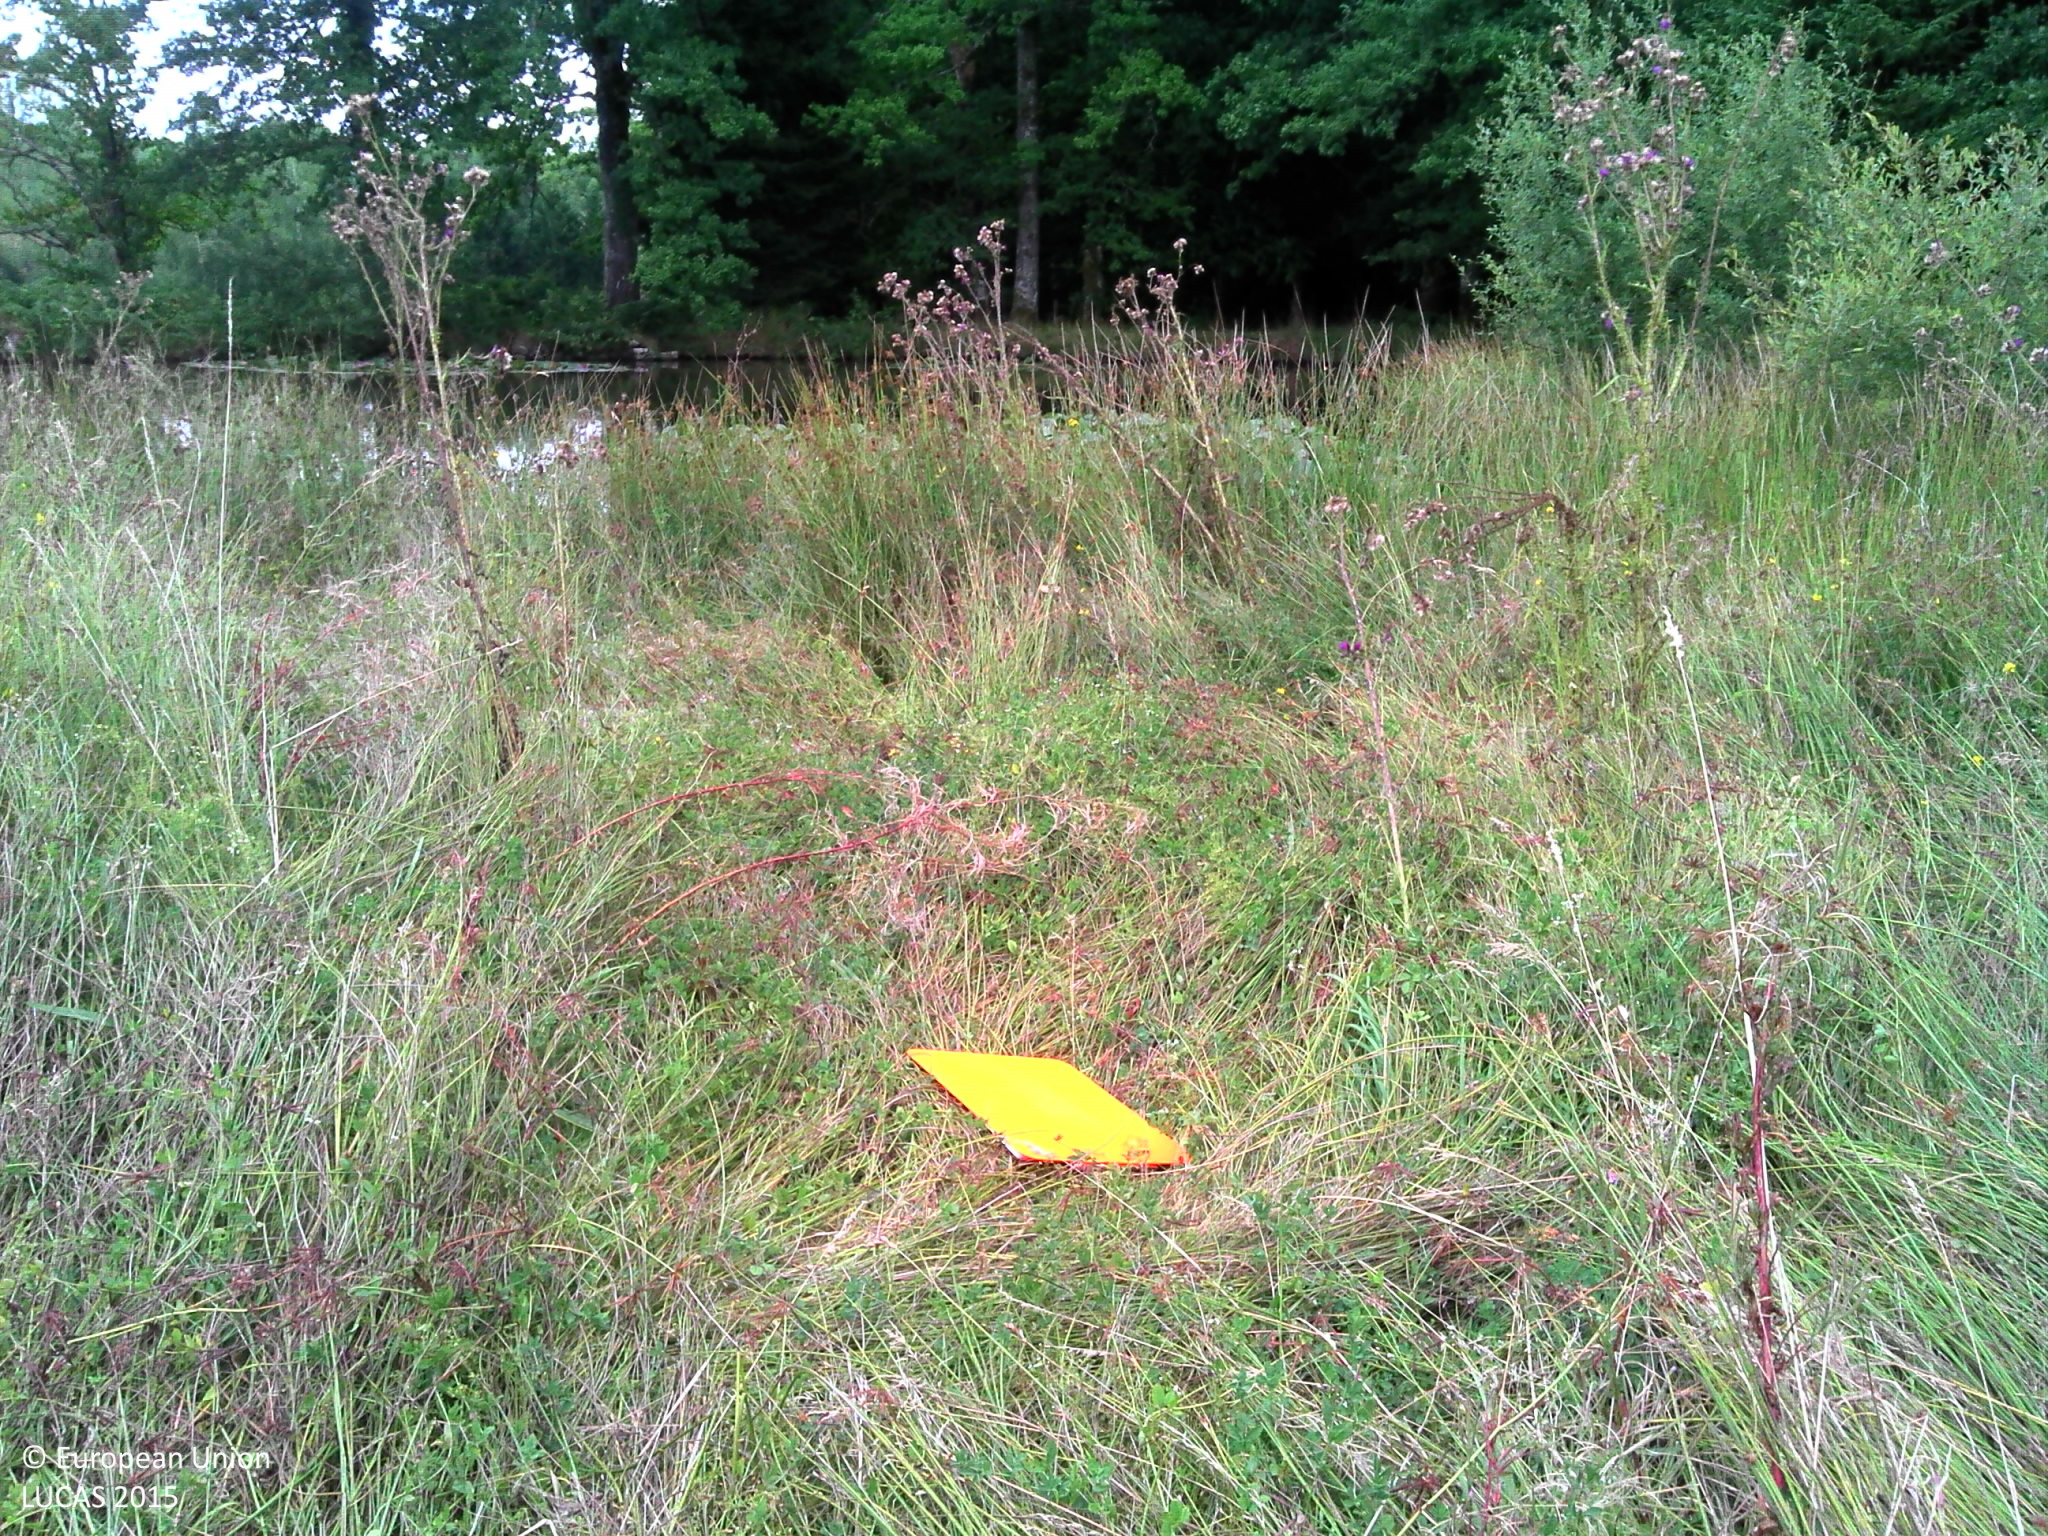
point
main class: Grassland
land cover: Grassland without tree/shrub cover
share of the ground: > 75 %
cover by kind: herbaceous plants 100 %
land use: Agriculture (excluding fallow land and kitchen gardens)
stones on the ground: < 10 %
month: July
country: FR
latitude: 45.5645
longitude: 0.6993
